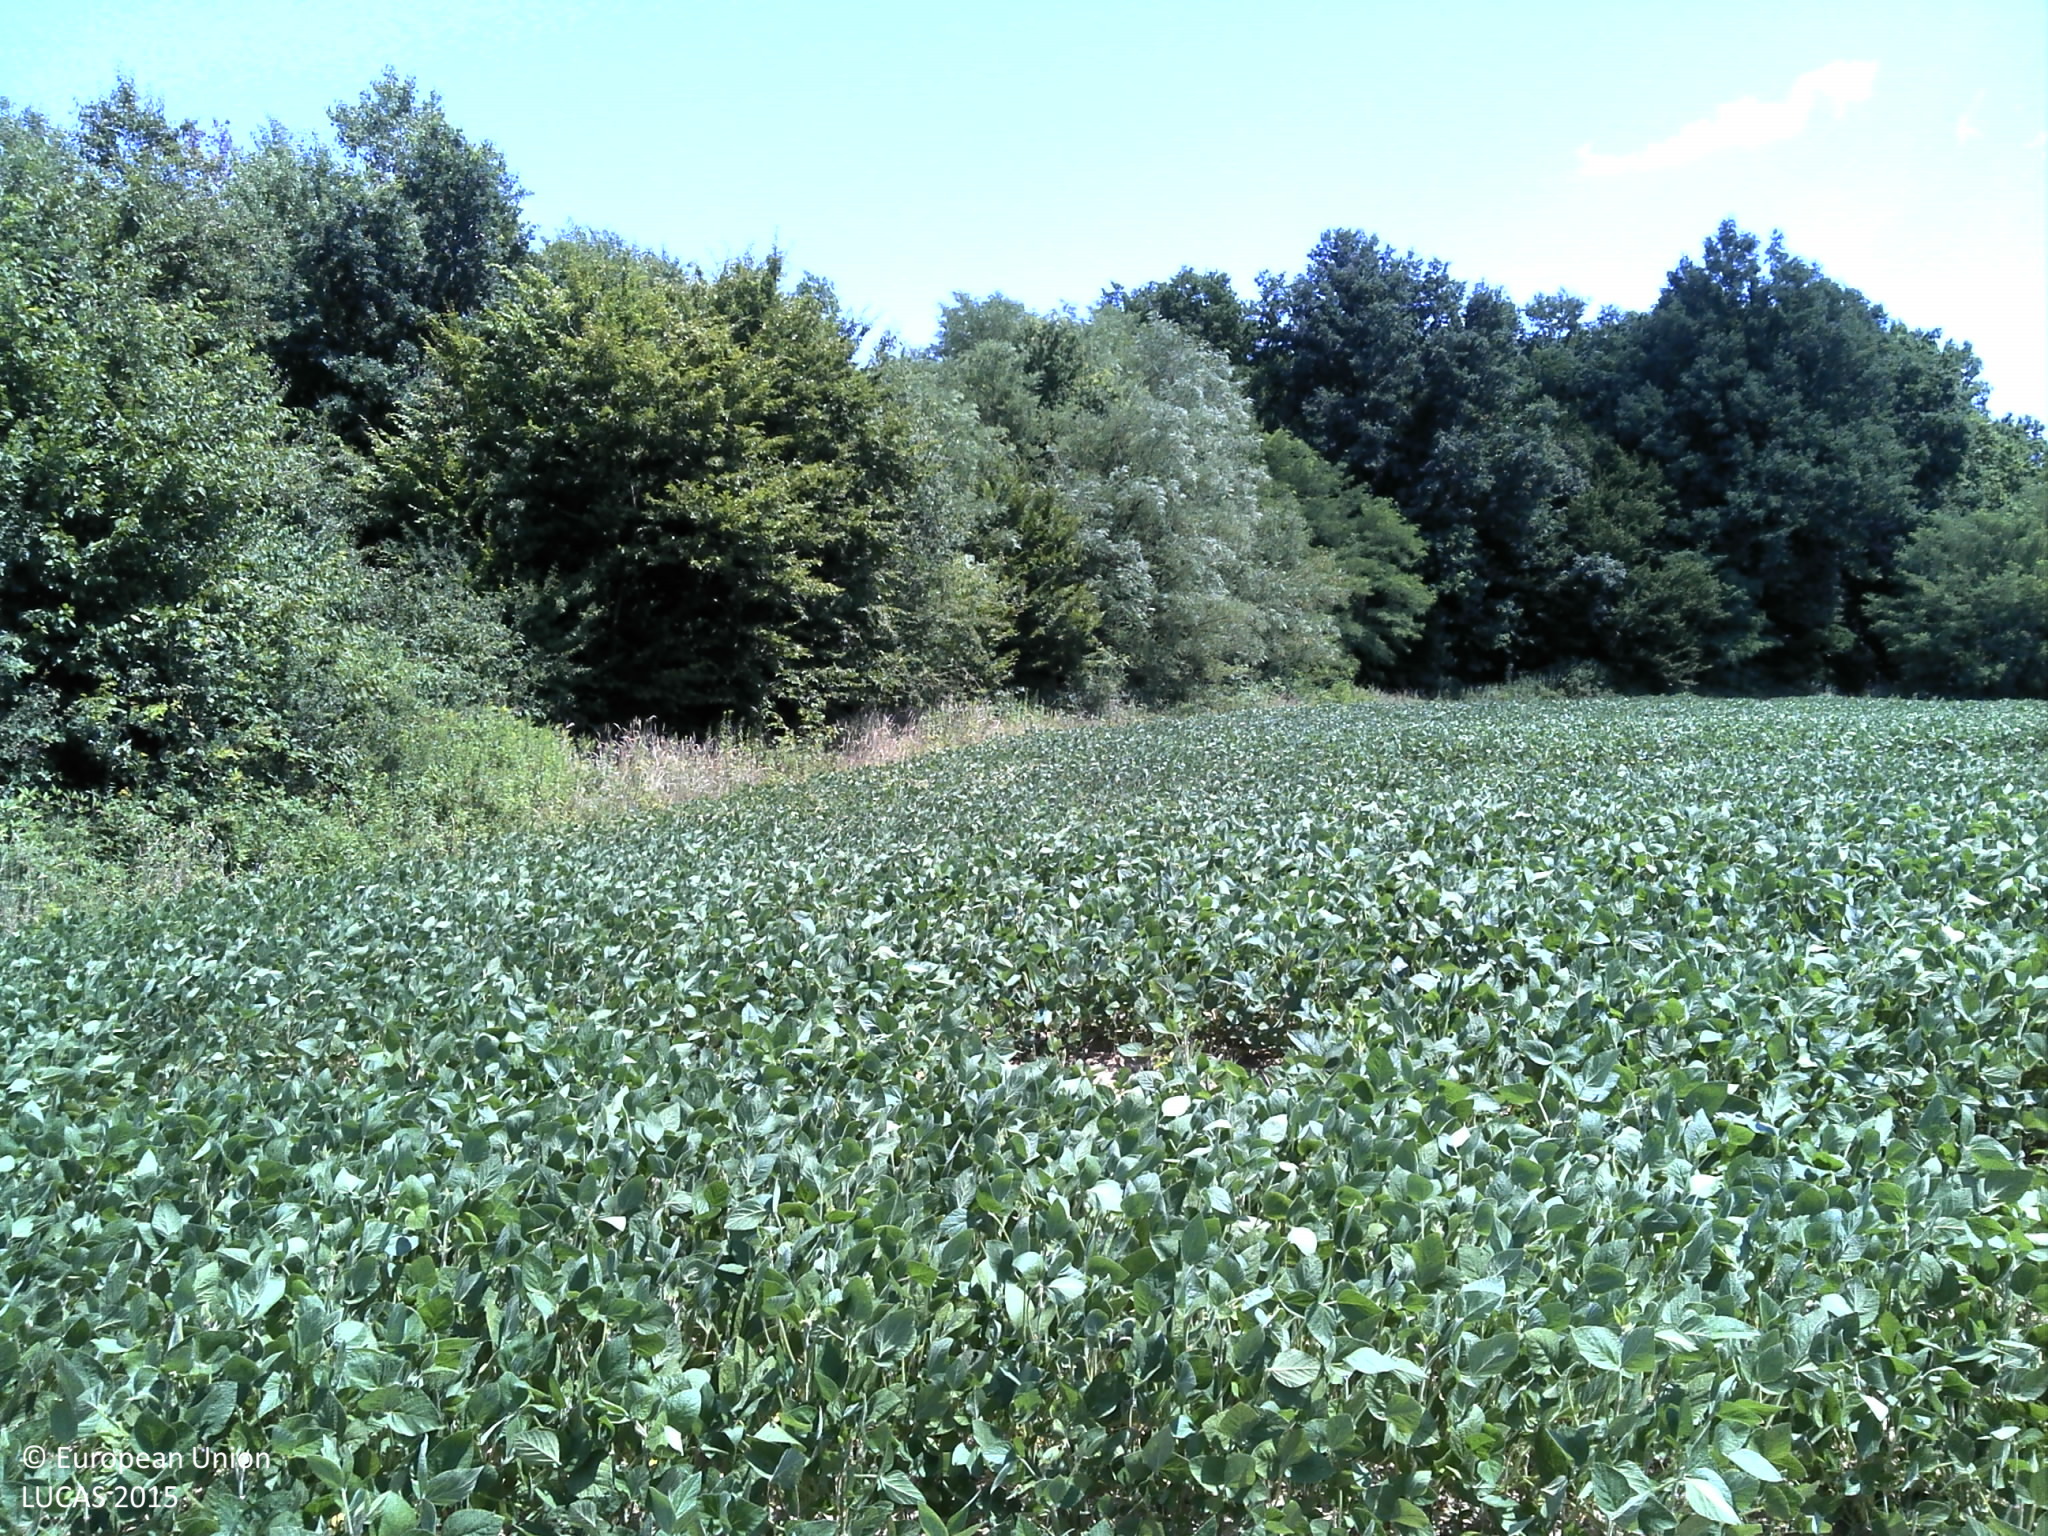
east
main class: Cropland
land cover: Soya
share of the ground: 50 - 75 %
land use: Agriculture (excluding fallow land and kitchen gardens)
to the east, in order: Soya; Tracks; Shrubland with sparse tree cover; Broadleaved woodland
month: July
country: HR
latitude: 45.5382
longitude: 16.7993
